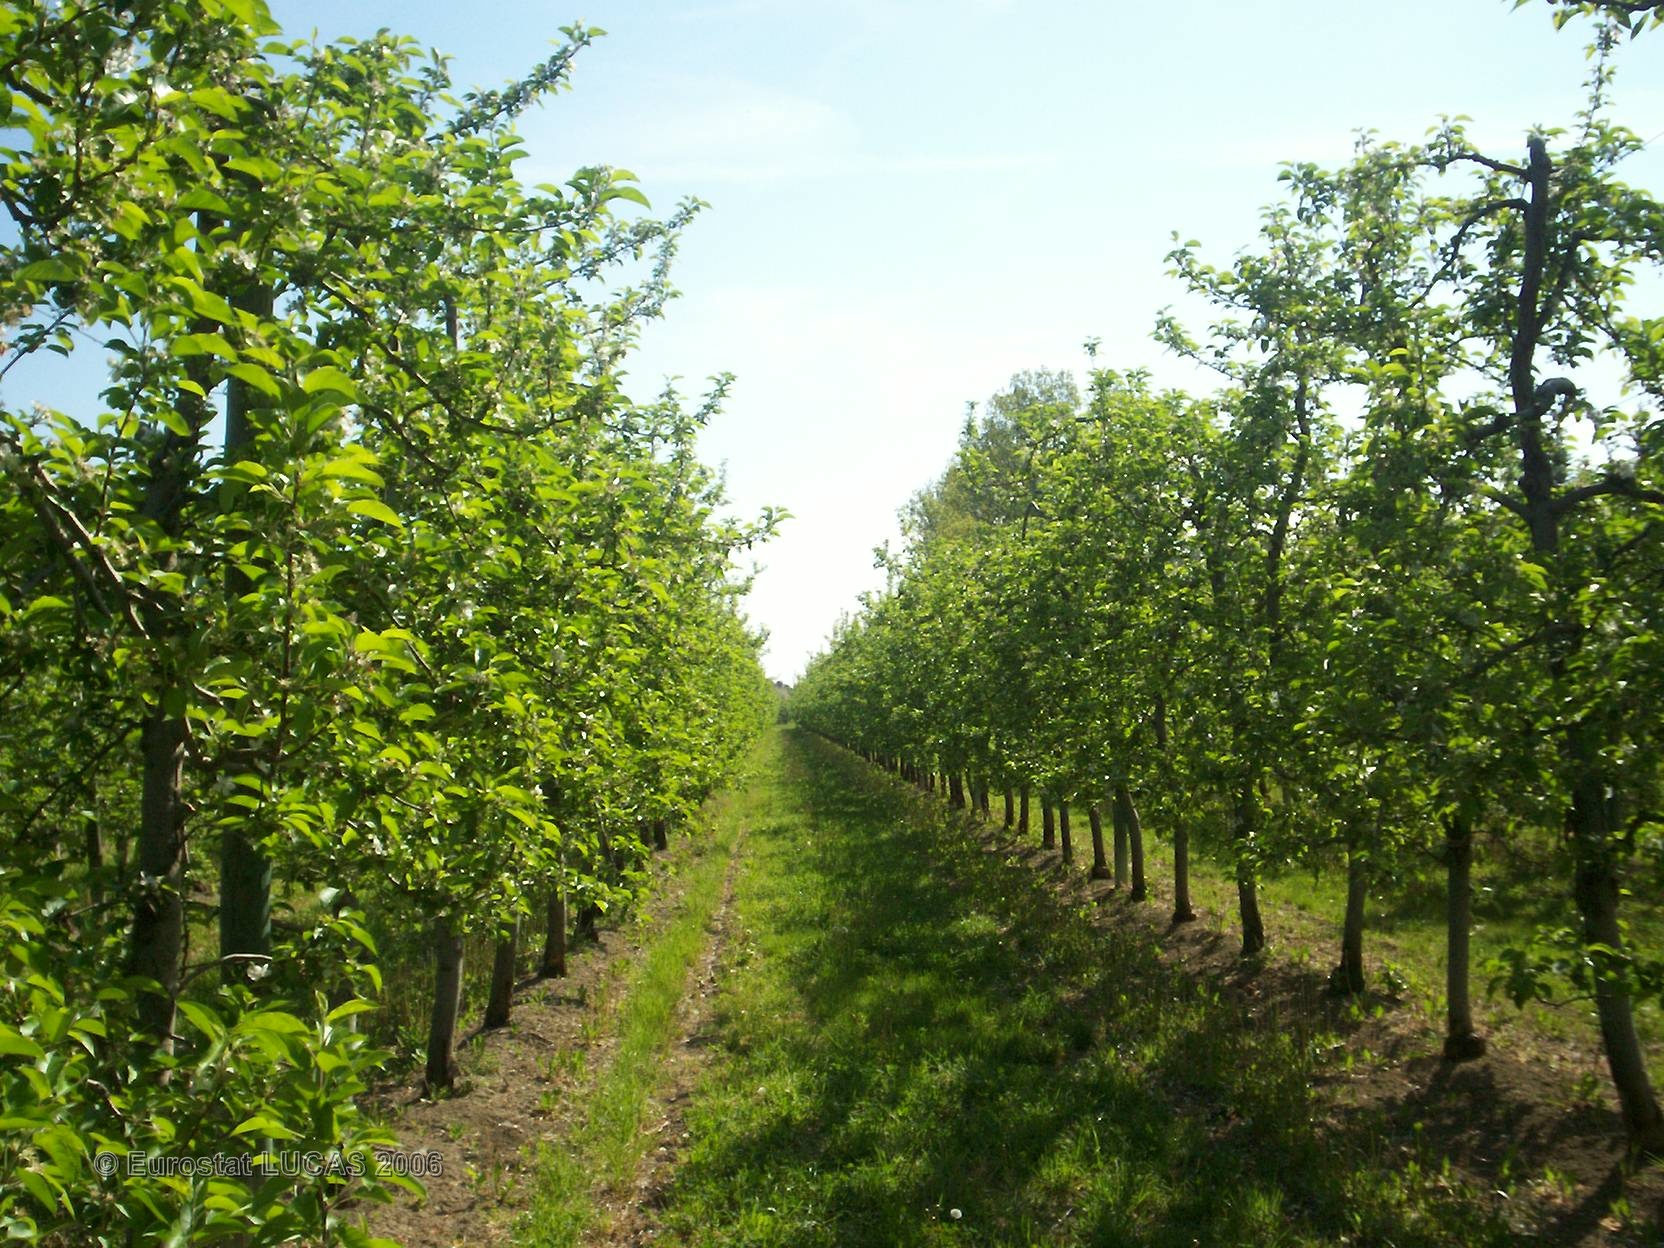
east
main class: Cropland
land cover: Apple fruit
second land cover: Grassland with sparse tree/shrub cover
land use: Agriculture (excluding fallow land and kitchen gardens)
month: April
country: FR
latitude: 43.8864
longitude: 4.9926
